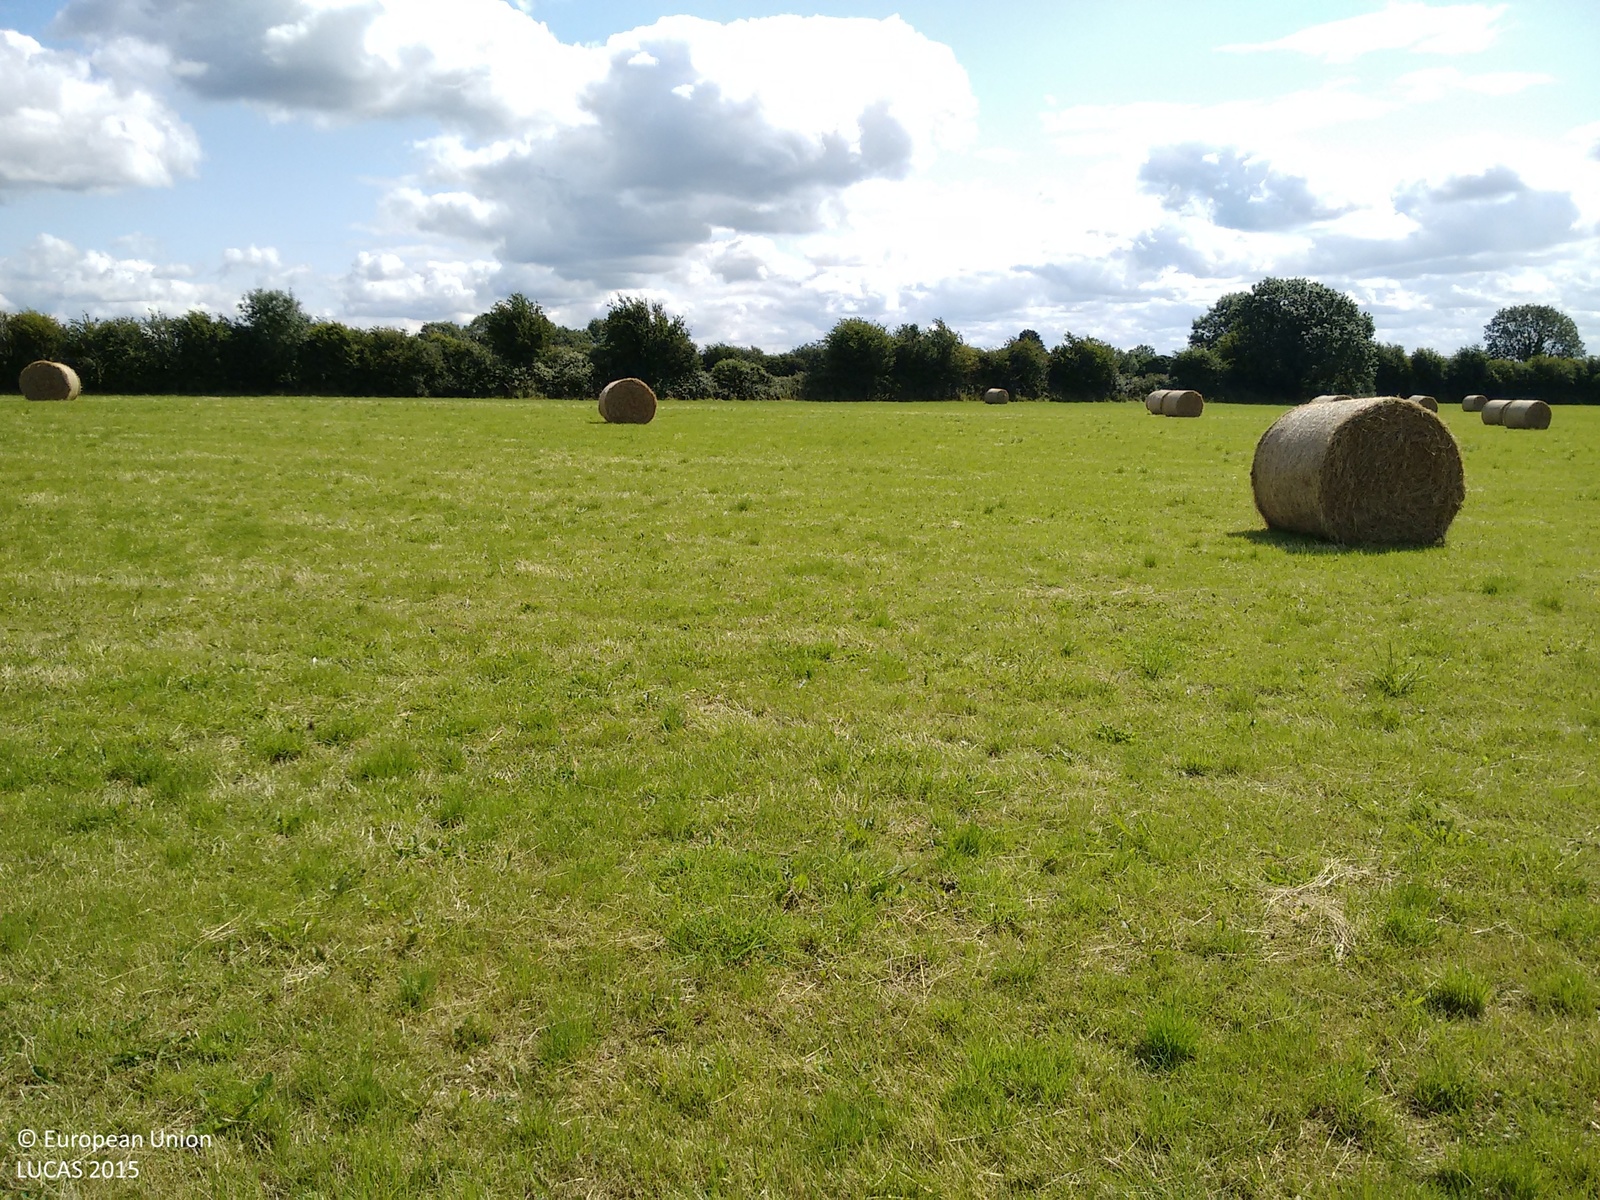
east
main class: Grassland
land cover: Grassland without tree/shrub cover
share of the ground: > 75 %
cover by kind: herbaceous plants 100 %
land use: Agriculture (excluding fallow land and kitchen gardens)
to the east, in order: Grassland without tree/shrub cover; Managed hedges; Dry stone walls; Fences; Grassland without tree/shrub cover; Managed hedges; Grassland without tree/shrub cover
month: July
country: IE
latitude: 53.5585
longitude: -7.9413
